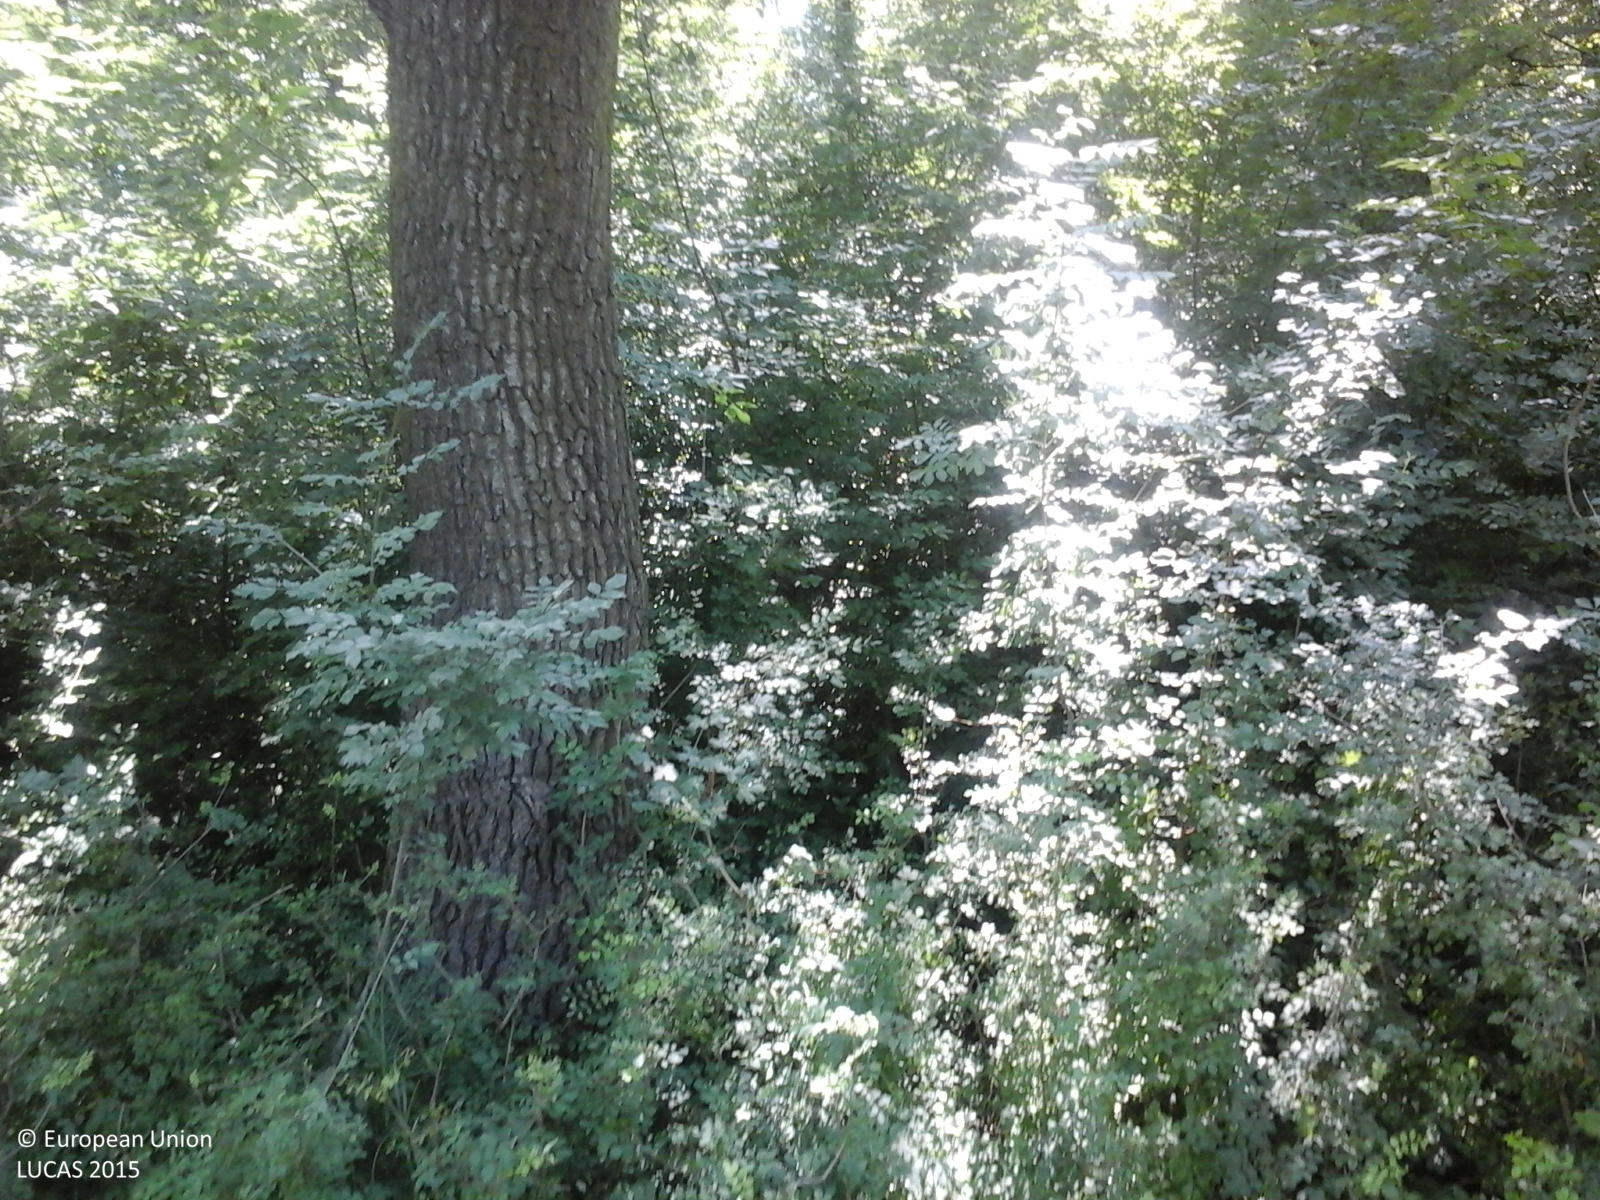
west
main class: Grassland
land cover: Spontaneously vegetated surfaces
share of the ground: > 75 %
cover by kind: herbaceous plants 100 %
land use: Fallow land
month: July
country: RO
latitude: 44.1659
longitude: 24.5124
